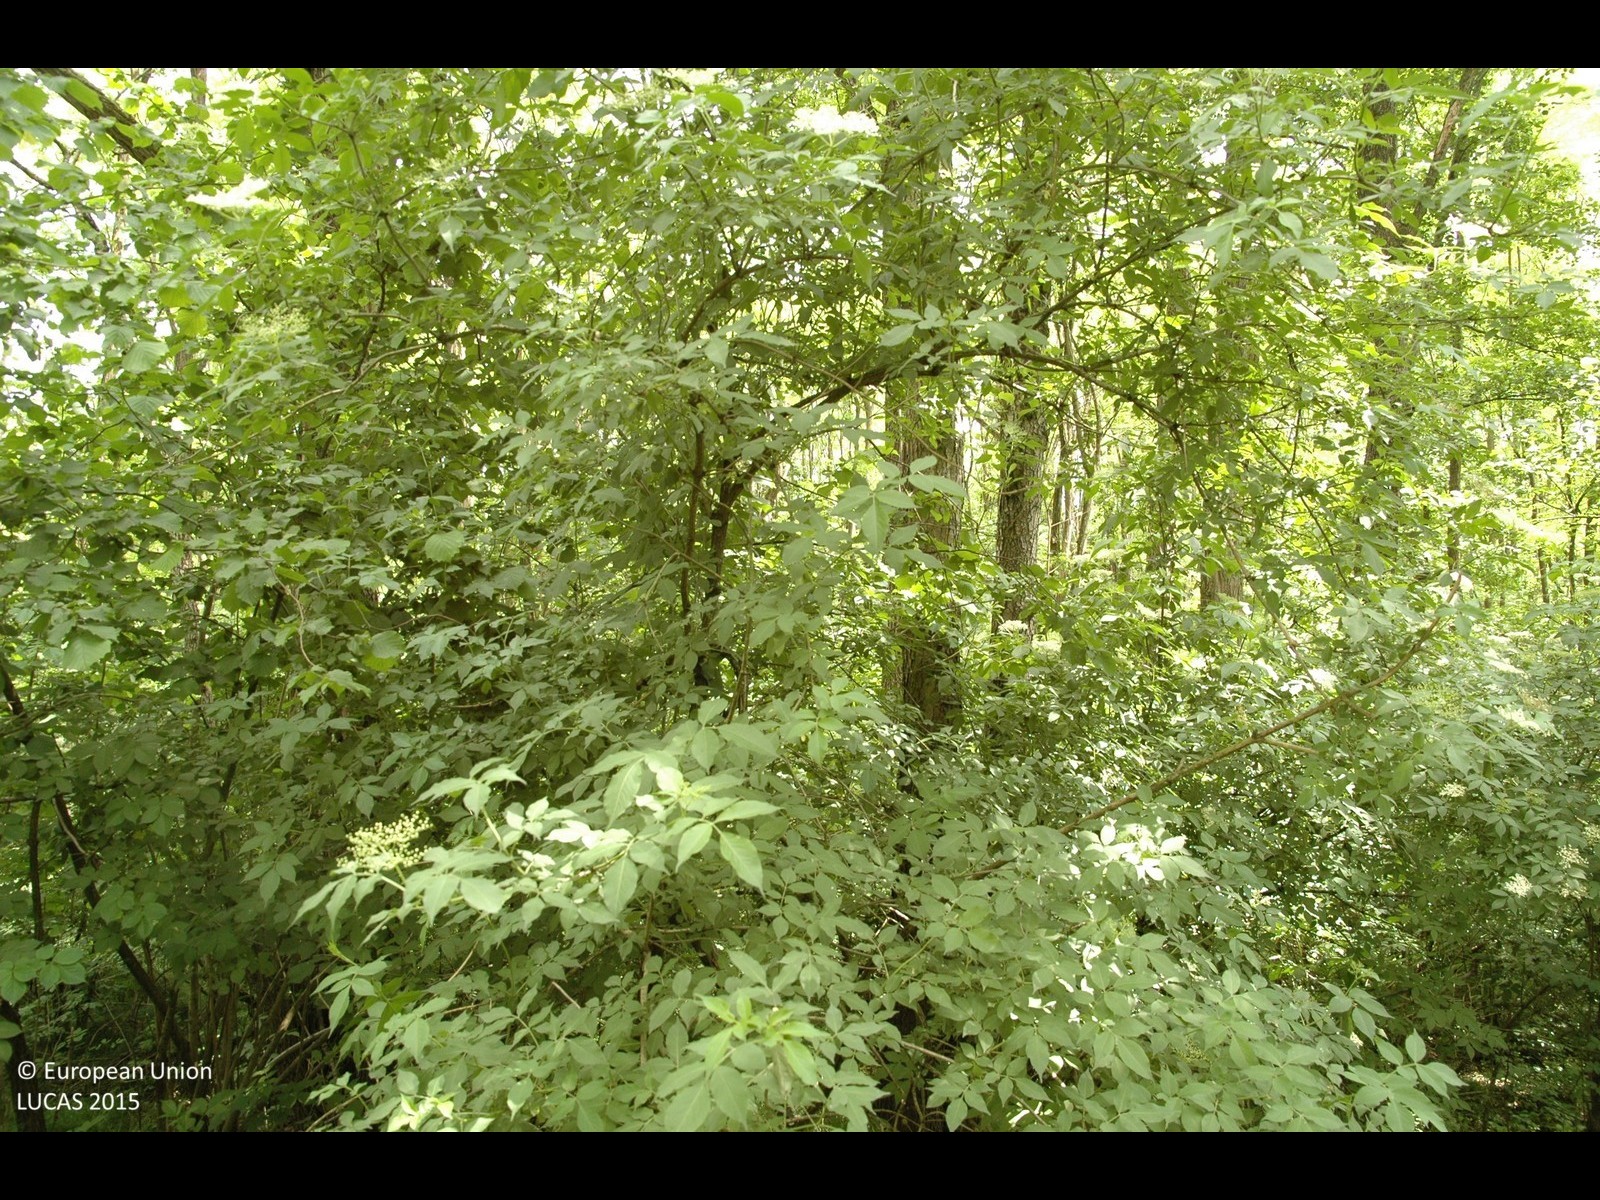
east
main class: Woodland
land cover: Broadleaved woodland
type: mesophytic deciduous forest
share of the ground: > 75 %
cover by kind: broadleaved forest trees 90 %, shrubs 5 %, herbaceous plants 5 %
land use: Forestry
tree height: > 5 m
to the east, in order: Broadleaved woodland; Rivers and streams; Broadleaved woodland; Artificial constructions in urban areas; Paved roads, cycling and walking lanes; Broadleaved woodland
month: May
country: HR
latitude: 46.4100
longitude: 16.4401
